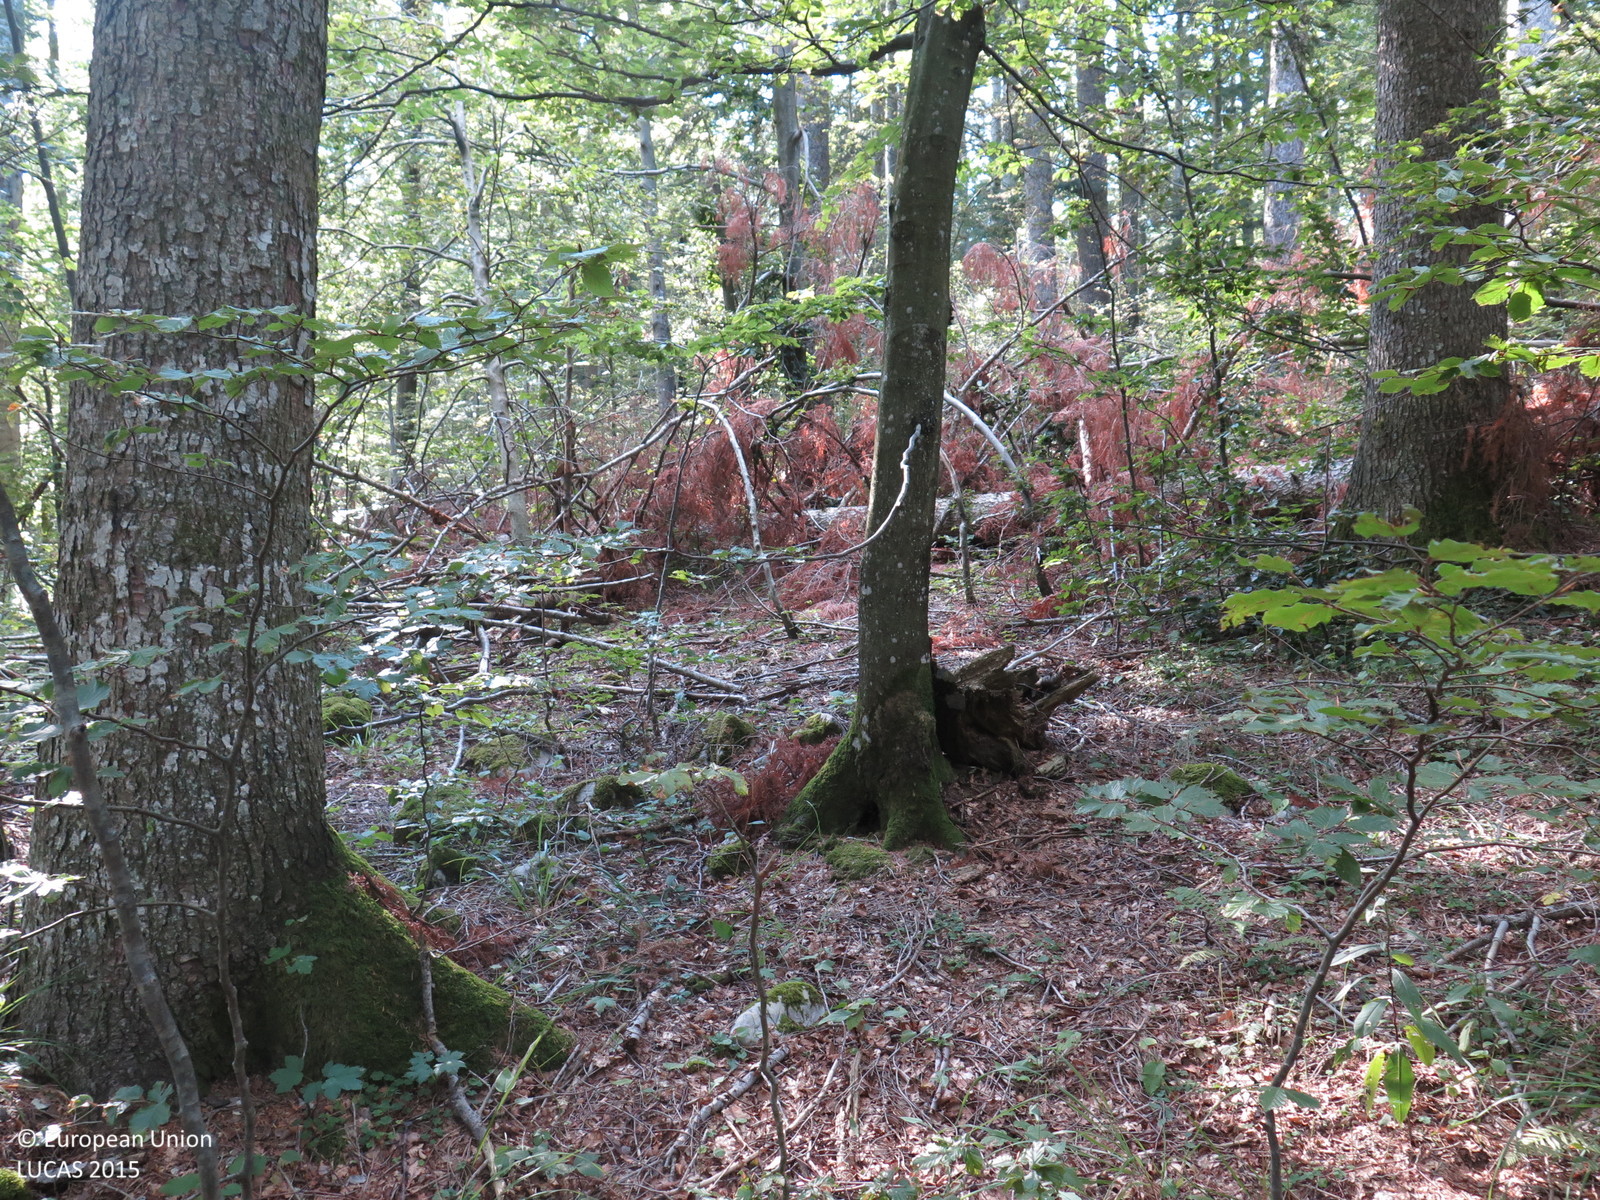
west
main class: Woodland
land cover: Other mixed woodland
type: alpine coniferous forest
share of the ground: > 75 %
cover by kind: coniferous forest trees 75 %, broadleaved forest trees 25 %
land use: Forestry
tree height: > 5 m
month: September
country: HR
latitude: 45.4151
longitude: 14.7616
